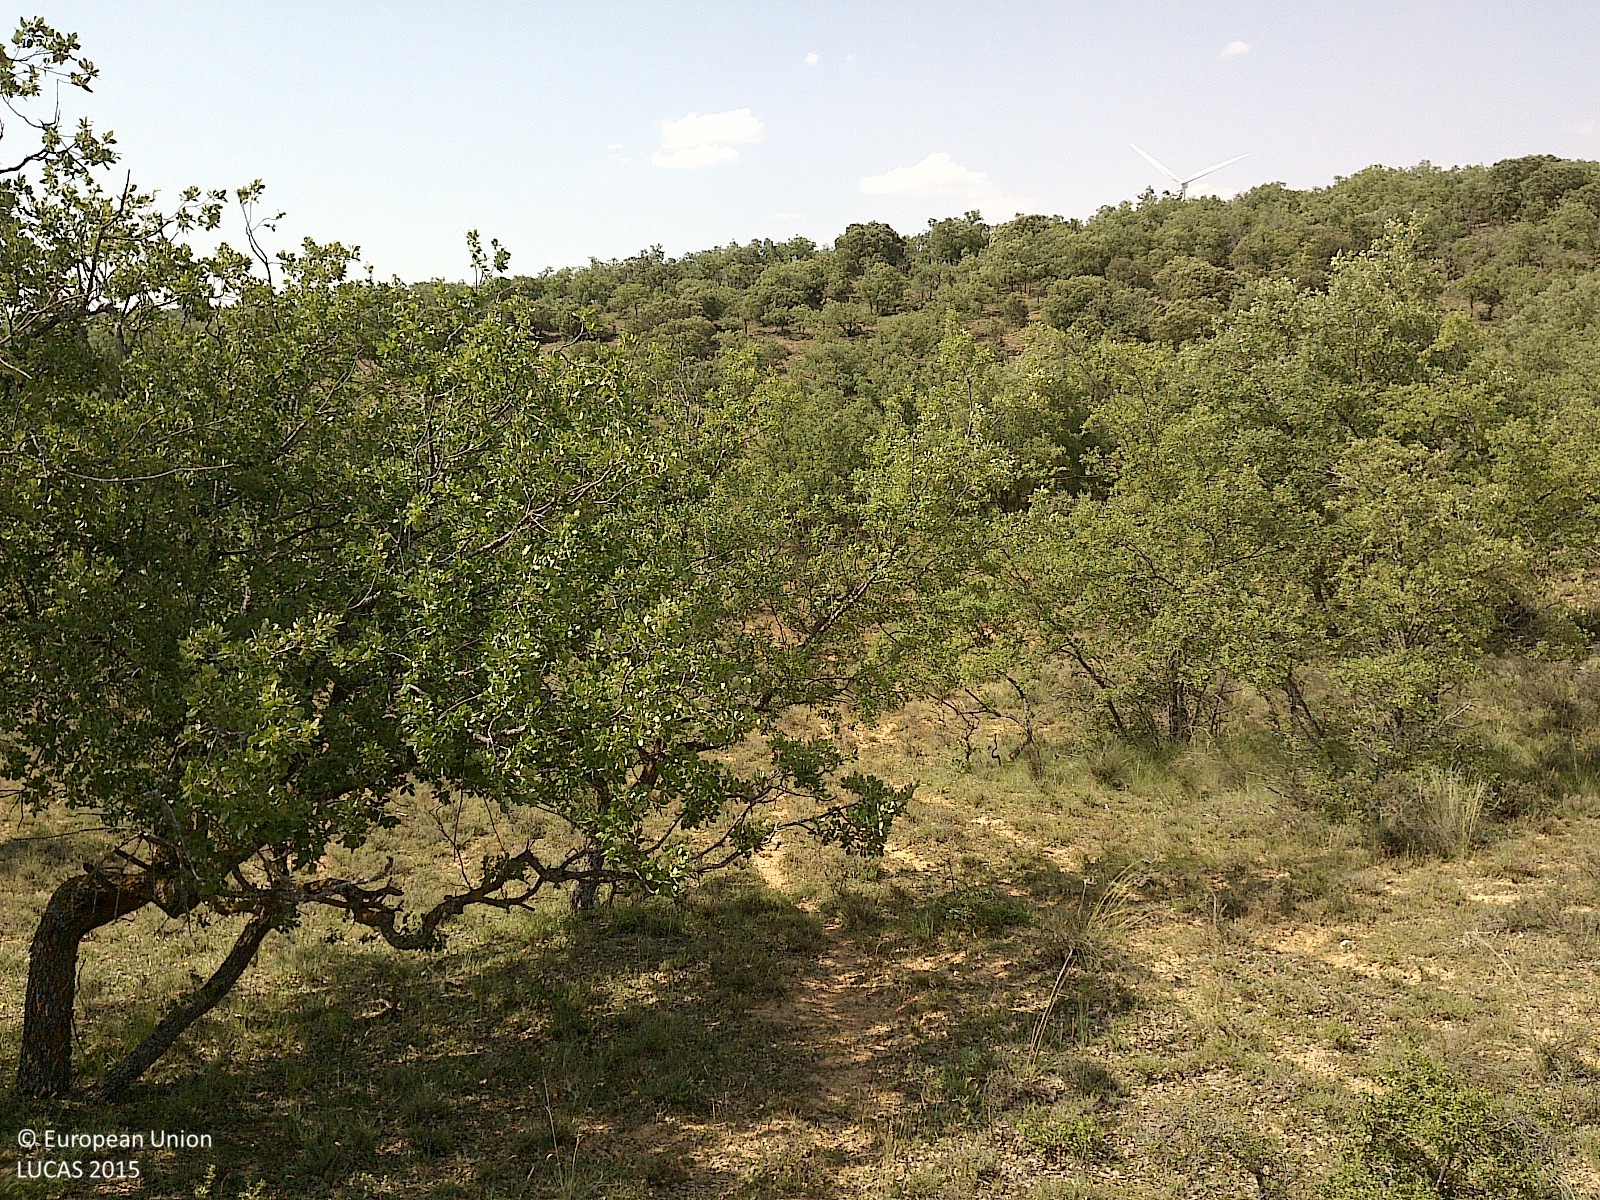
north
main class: Woodland
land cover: Broadleaved woodland
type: broadleaved evergreen forest
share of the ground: 25 - 50 %
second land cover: Grassland without tree/shrub cover
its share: 50 - 75 %
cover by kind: herbaceous plants 50 %, broadleaved forest trees 30 %, shrubs 10 %, unconsolidated bare surface 10 %
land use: Forestry
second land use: Agriculture (excluding fallow land and kitchen gardens)
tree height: < 5 m
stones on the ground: < 10 %
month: June
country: ES
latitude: 41.5426
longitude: -2.2483
